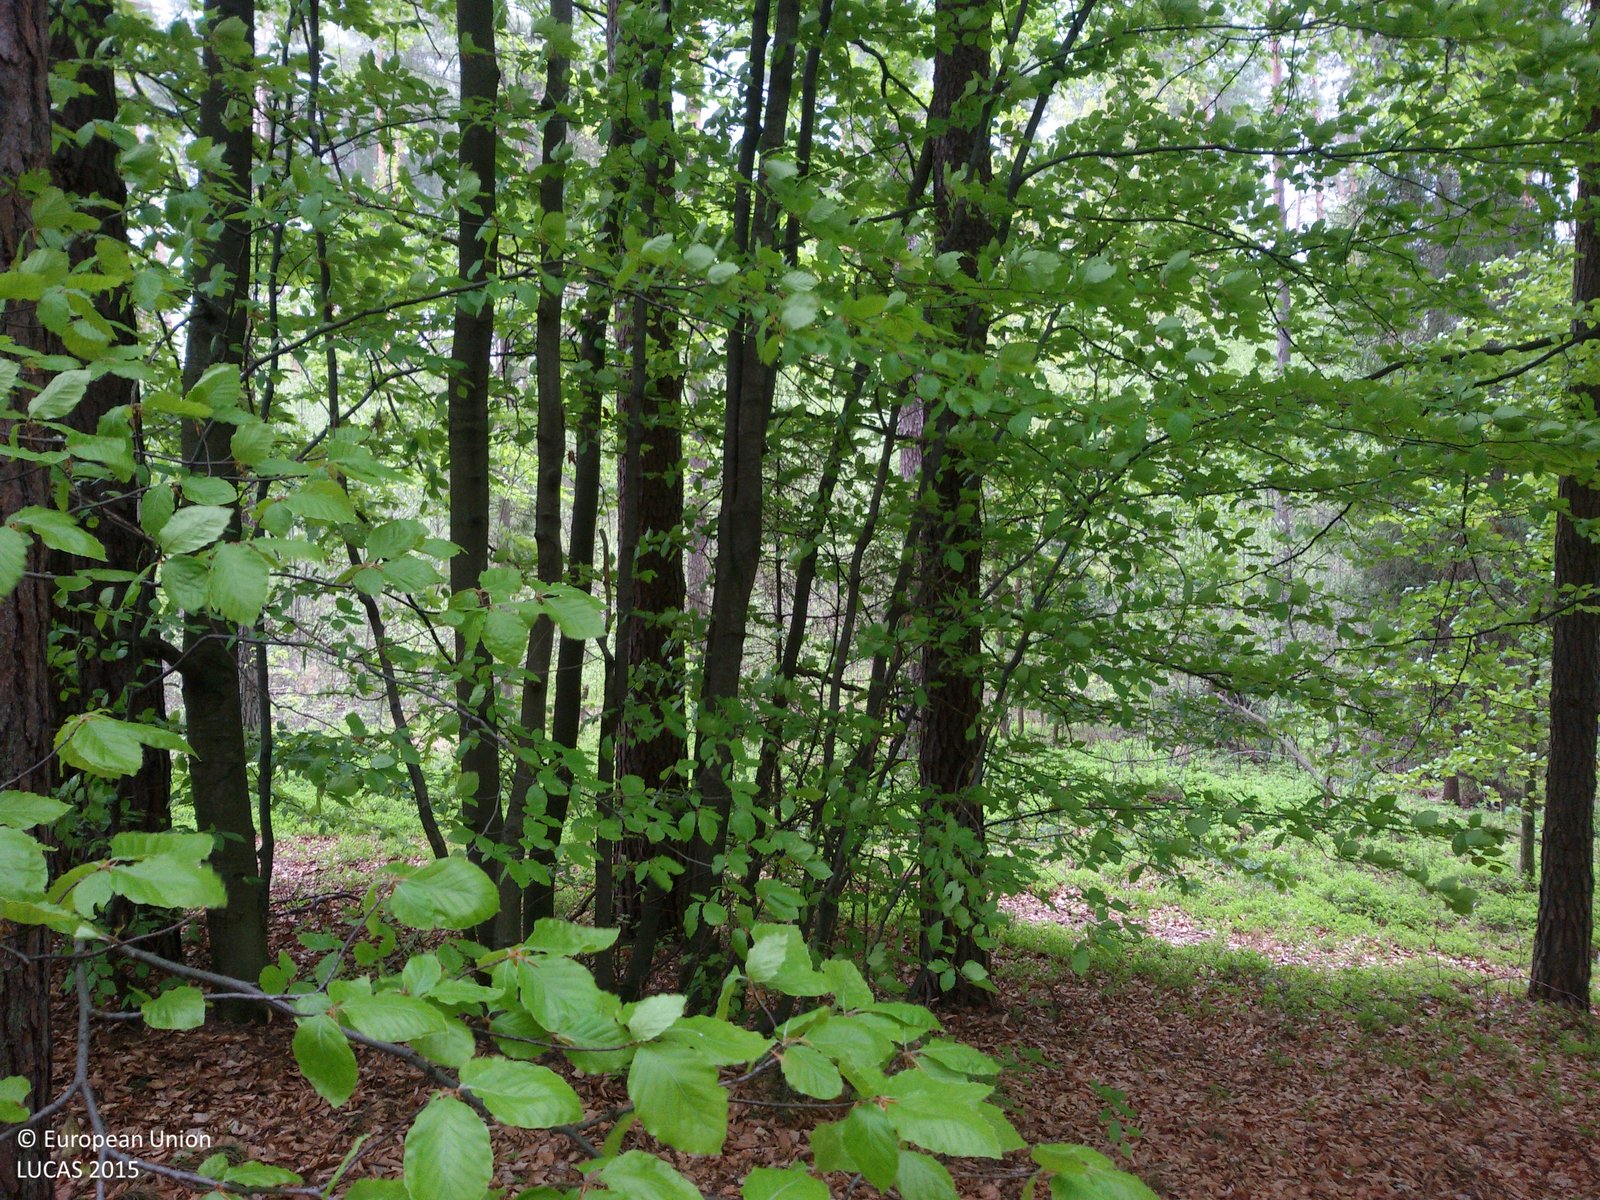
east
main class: Woodland
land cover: Pine dominated mixed woodland
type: hemiboreal forest and nemoral coniferous forest and mixed broadleaved-coniferous forest
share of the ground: > 75 %
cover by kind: coniferous forest trees 65 %, broadleaved forest trees 35 %
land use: Forestry
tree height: > 5 m
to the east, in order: Pine dominated mixed woodland; Ditches and canals; Pine dominated coniferous woodland; Tracks; Ditches and canals; Pine dominated mixed woodland
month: May
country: PL
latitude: 50.3454
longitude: 21.6743
